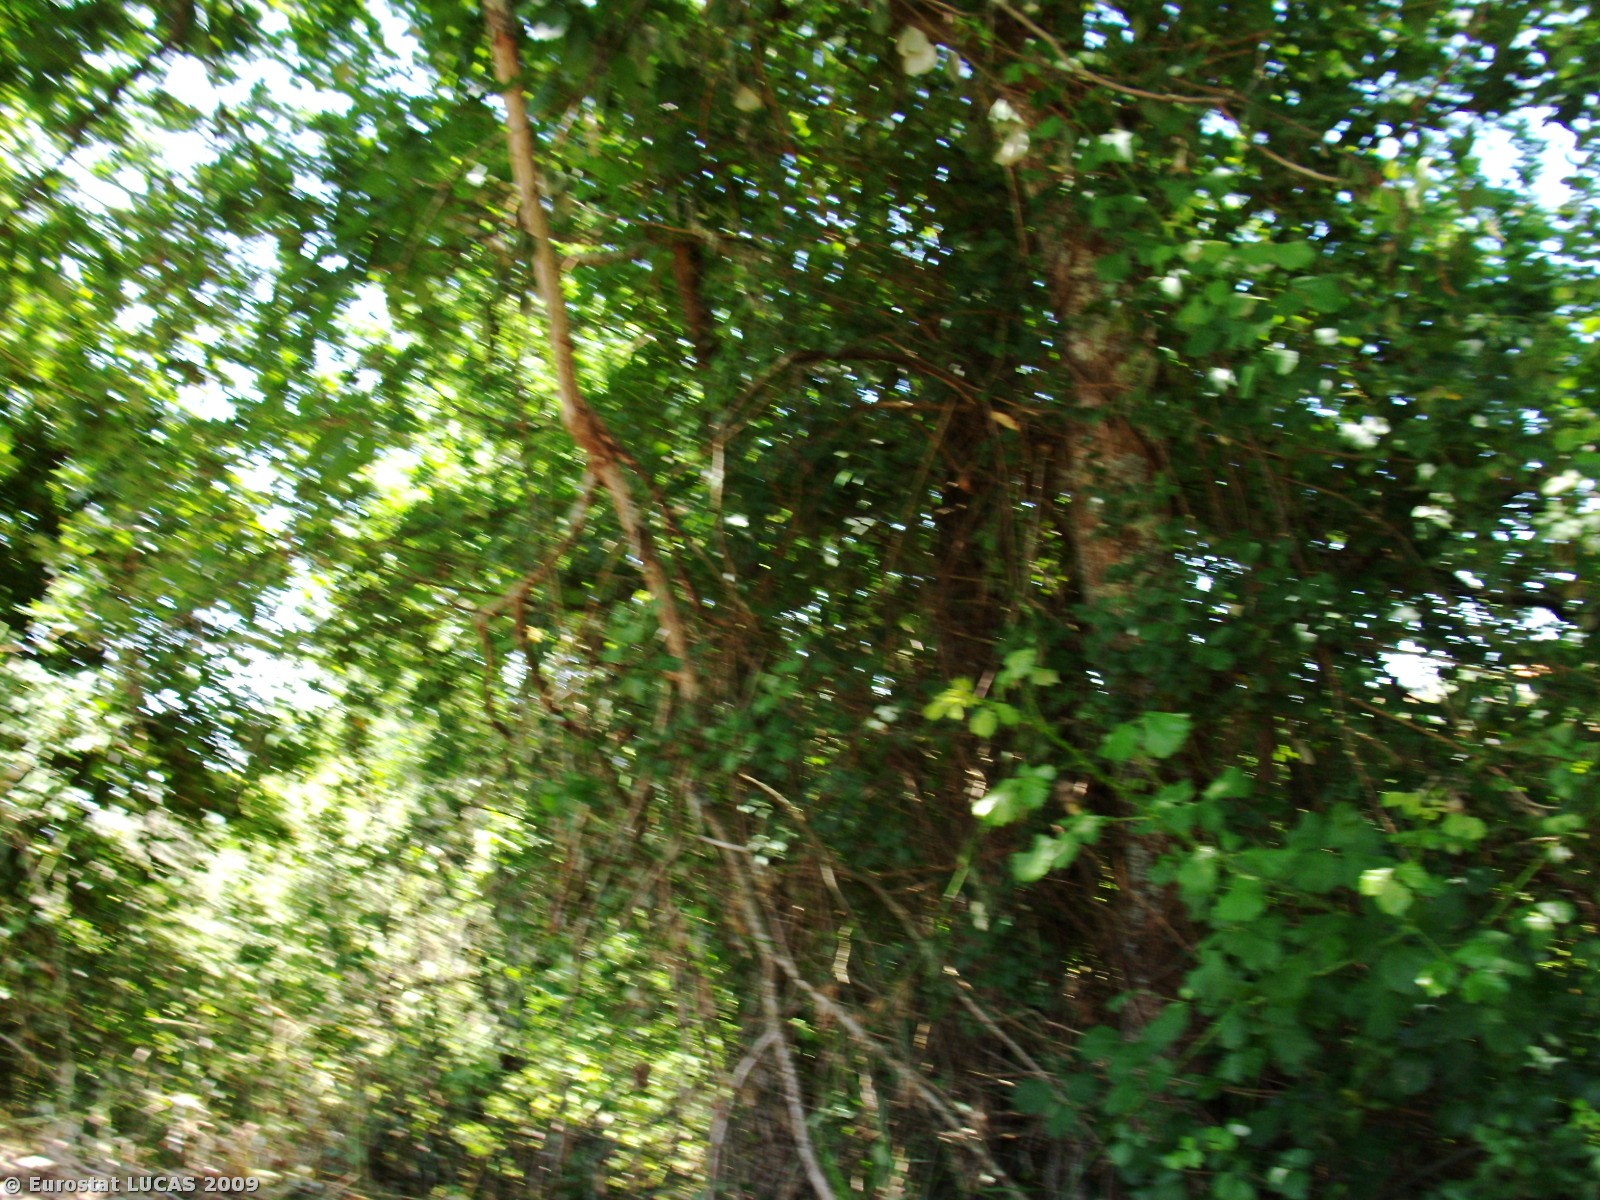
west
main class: Shrubland
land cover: Shrubland with sparse tree cover
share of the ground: > 75 %
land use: Fallow land
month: May
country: PT
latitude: 41.6494
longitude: -8.6162
